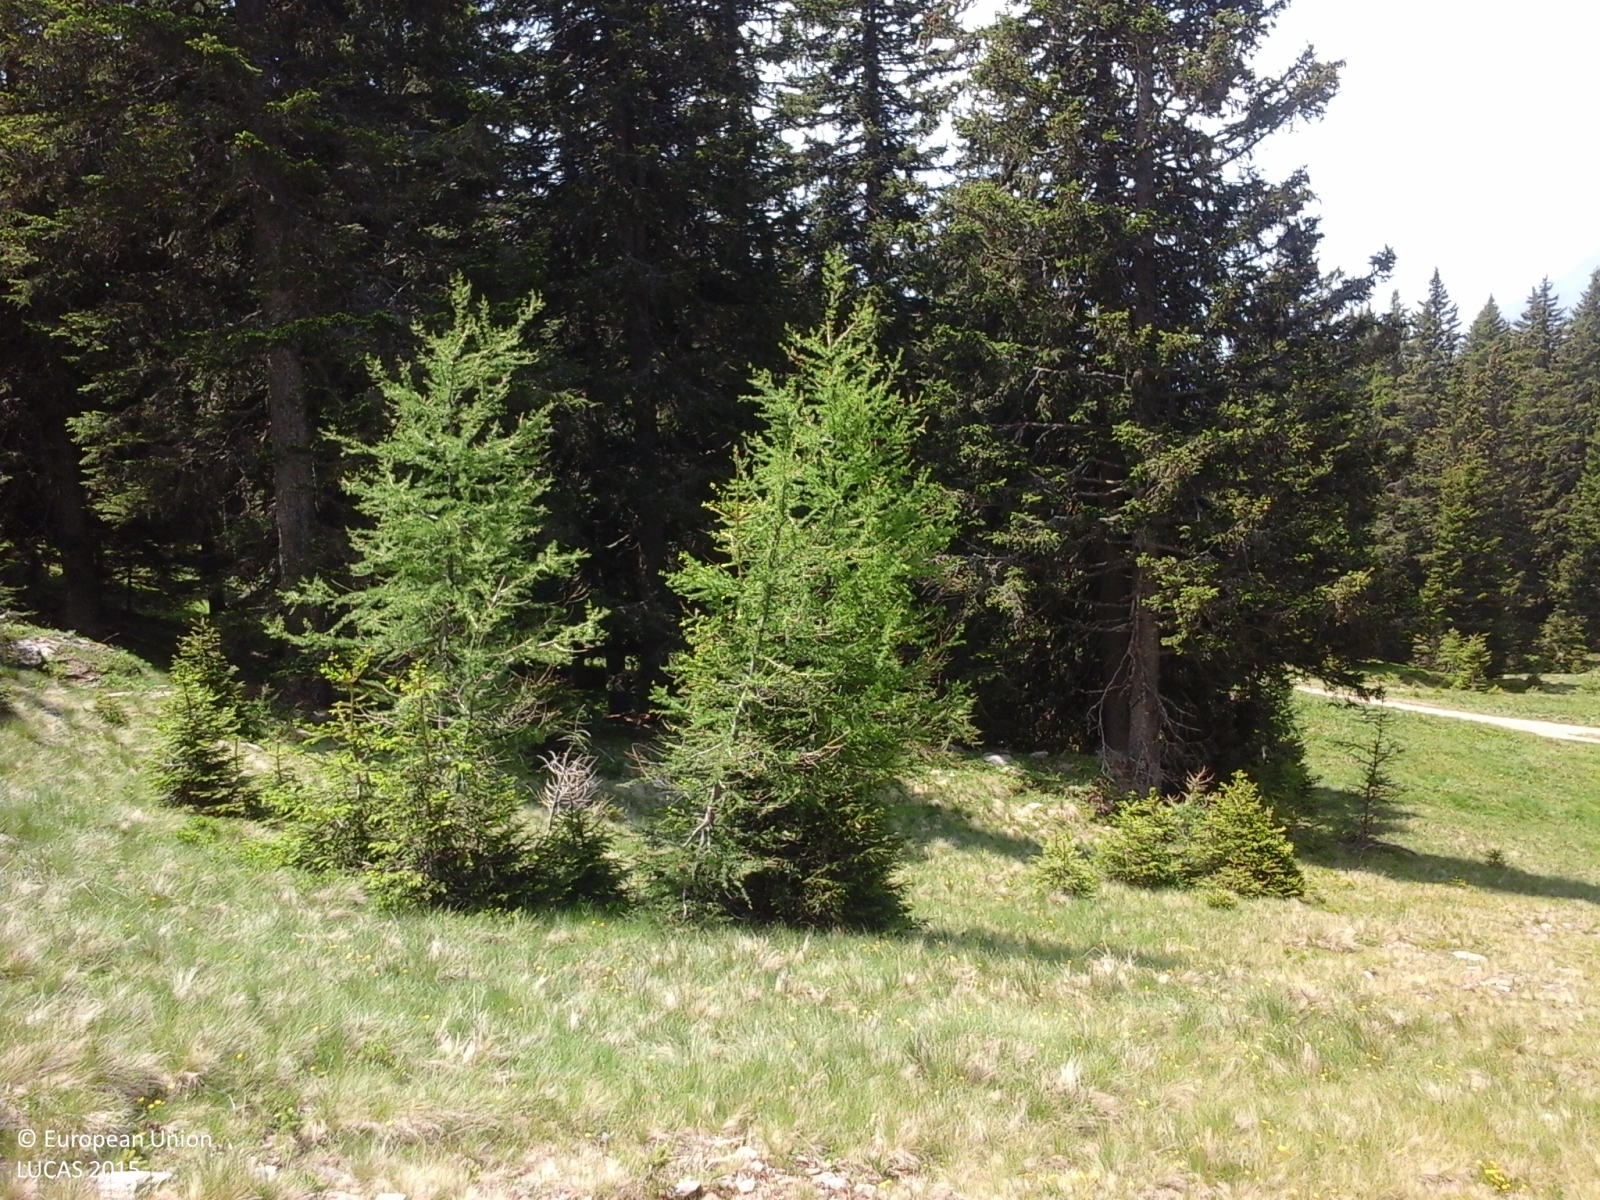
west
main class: Grassland
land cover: Grassland with sparse tree/shrub cover
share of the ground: > 75 %
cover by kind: herbaceous plants 95 %, coniferous forest trees 5 %
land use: Agriculture (excluding fallow land and kitchen gardens)
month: June
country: IT
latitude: 46.7403
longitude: 11.2419
